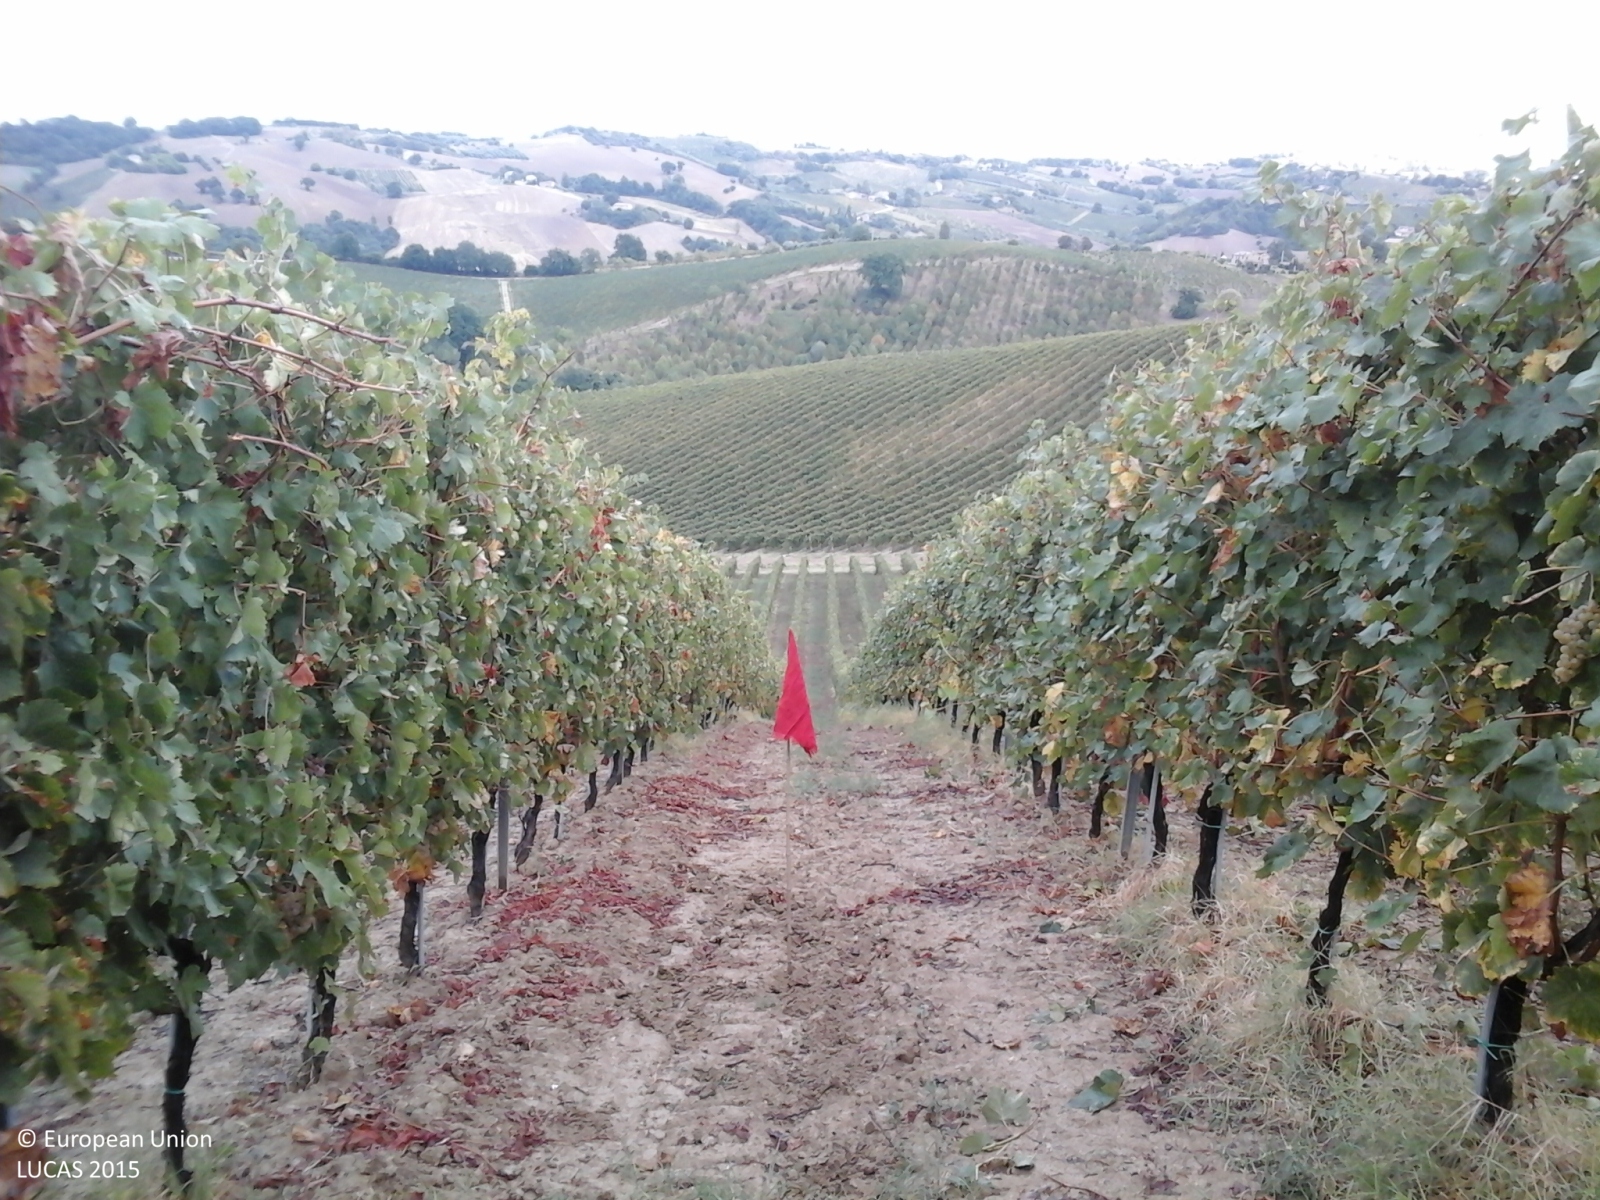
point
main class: Cropland
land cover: Vineyards
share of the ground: 50 - 75 %
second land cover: Other bare soil
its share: > 75 %
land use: Agriculture (excluding fallow land and kitchen gardens)
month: September
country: IT
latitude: 43.4364
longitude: 13.1424
